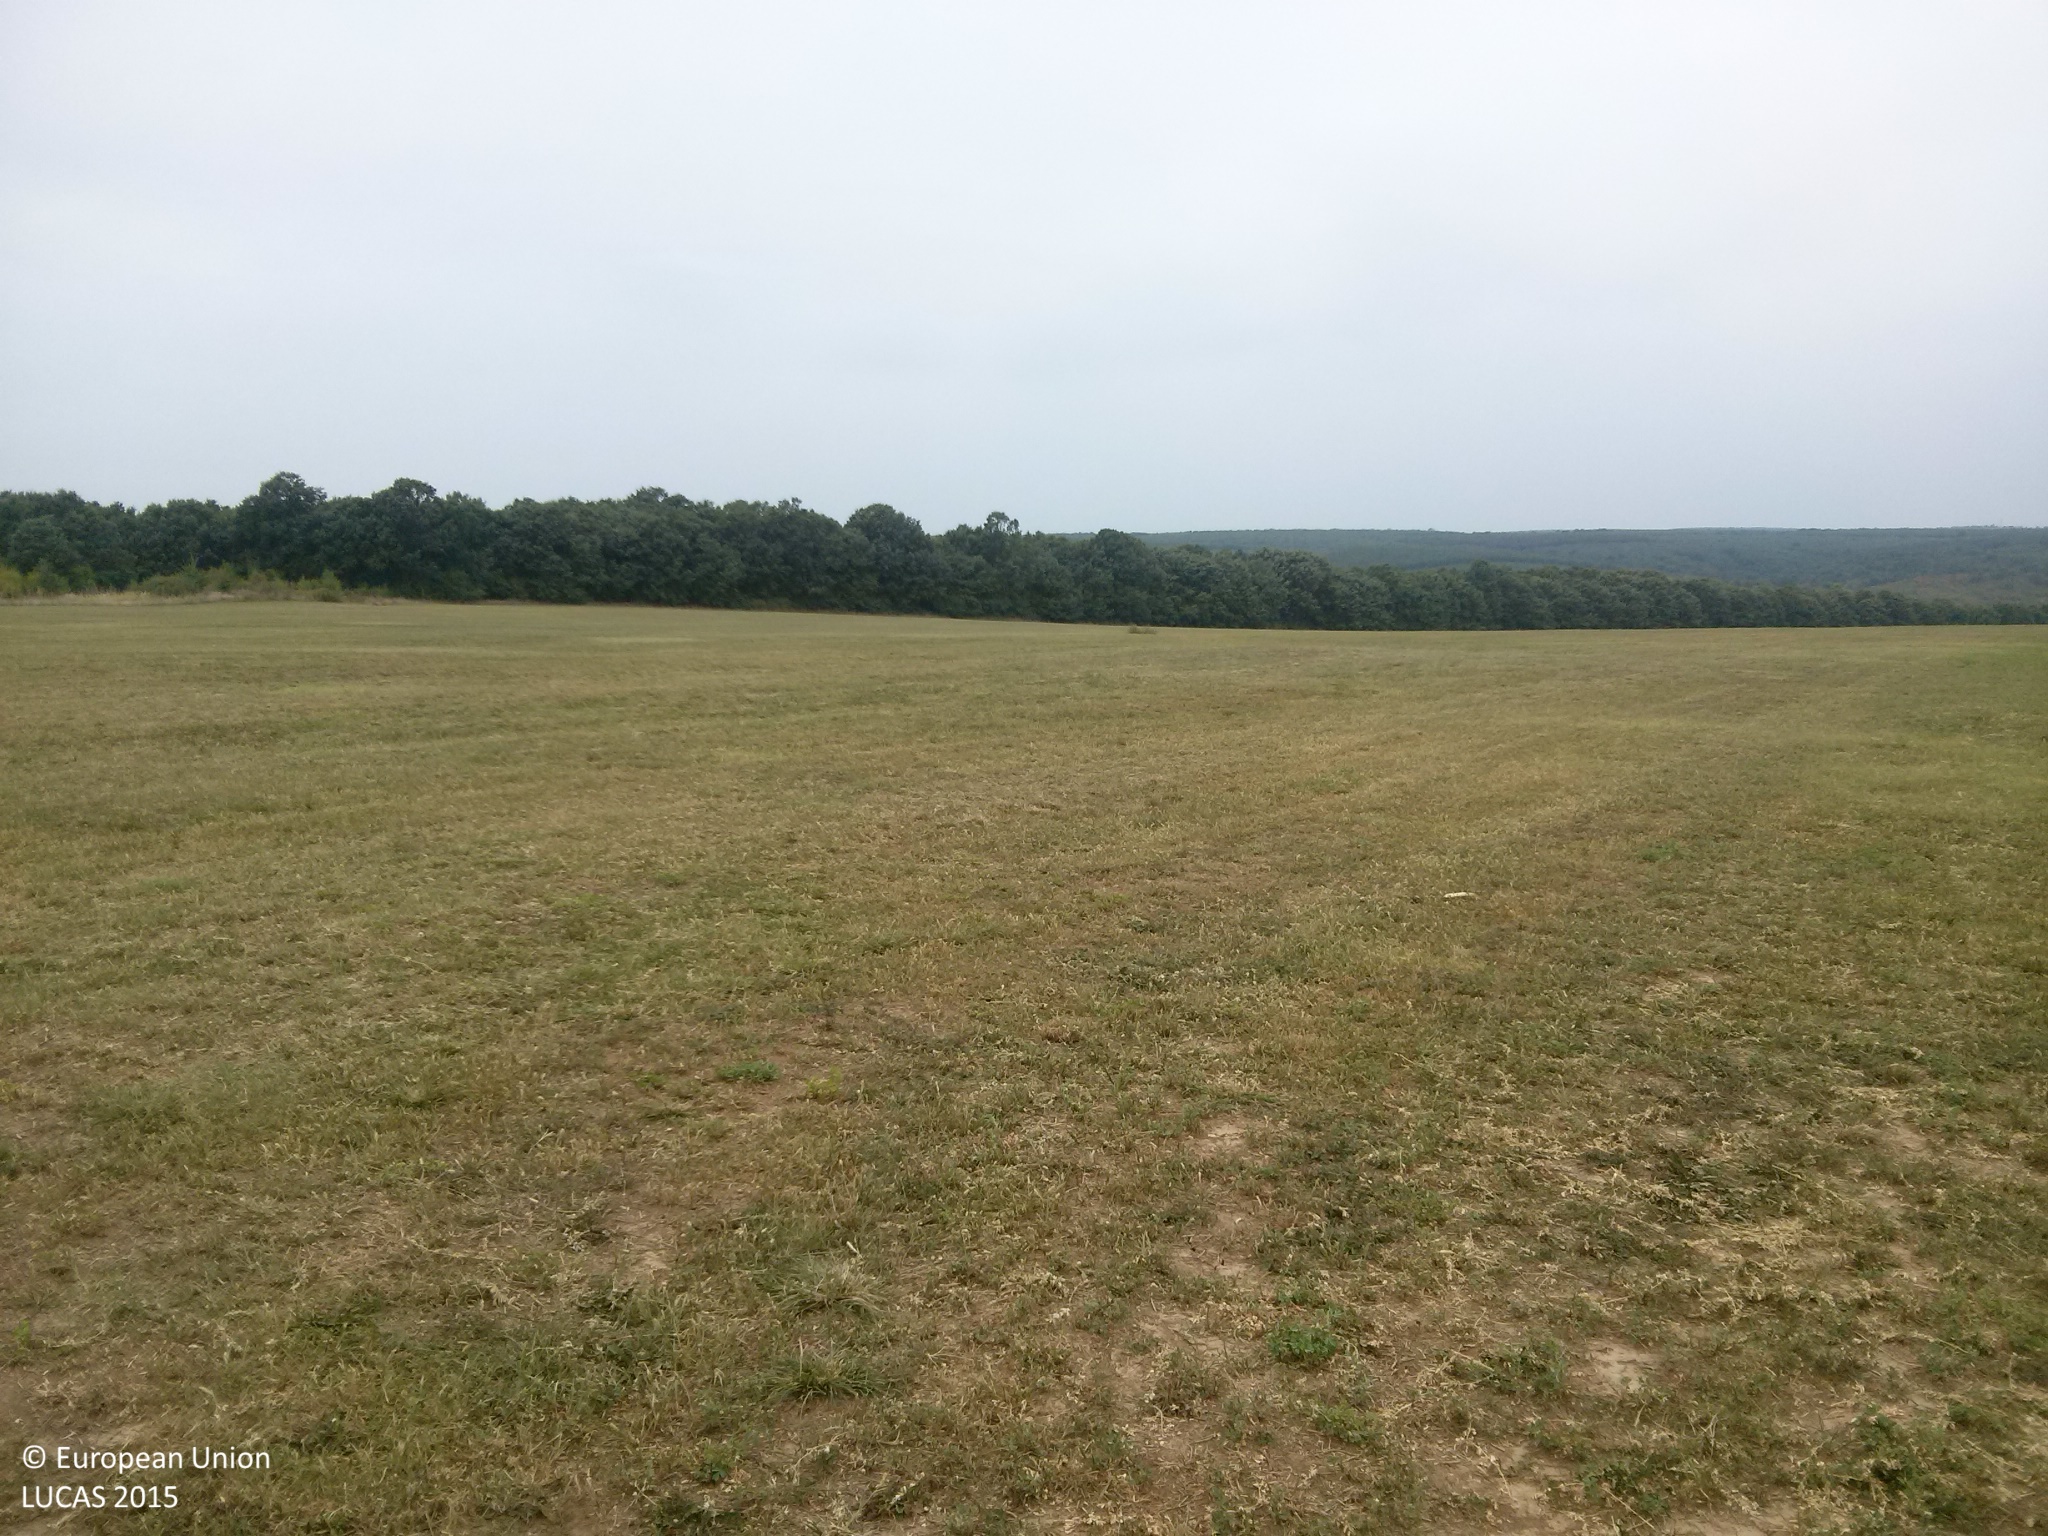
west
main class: Cropland
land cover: Lucerne
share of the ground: 50 - 75 %
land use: Agriculture (excluding fallow land and kitchen gardens)
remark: Harvested field
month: September
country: BG
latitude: 43.7469
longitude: 26.7670
